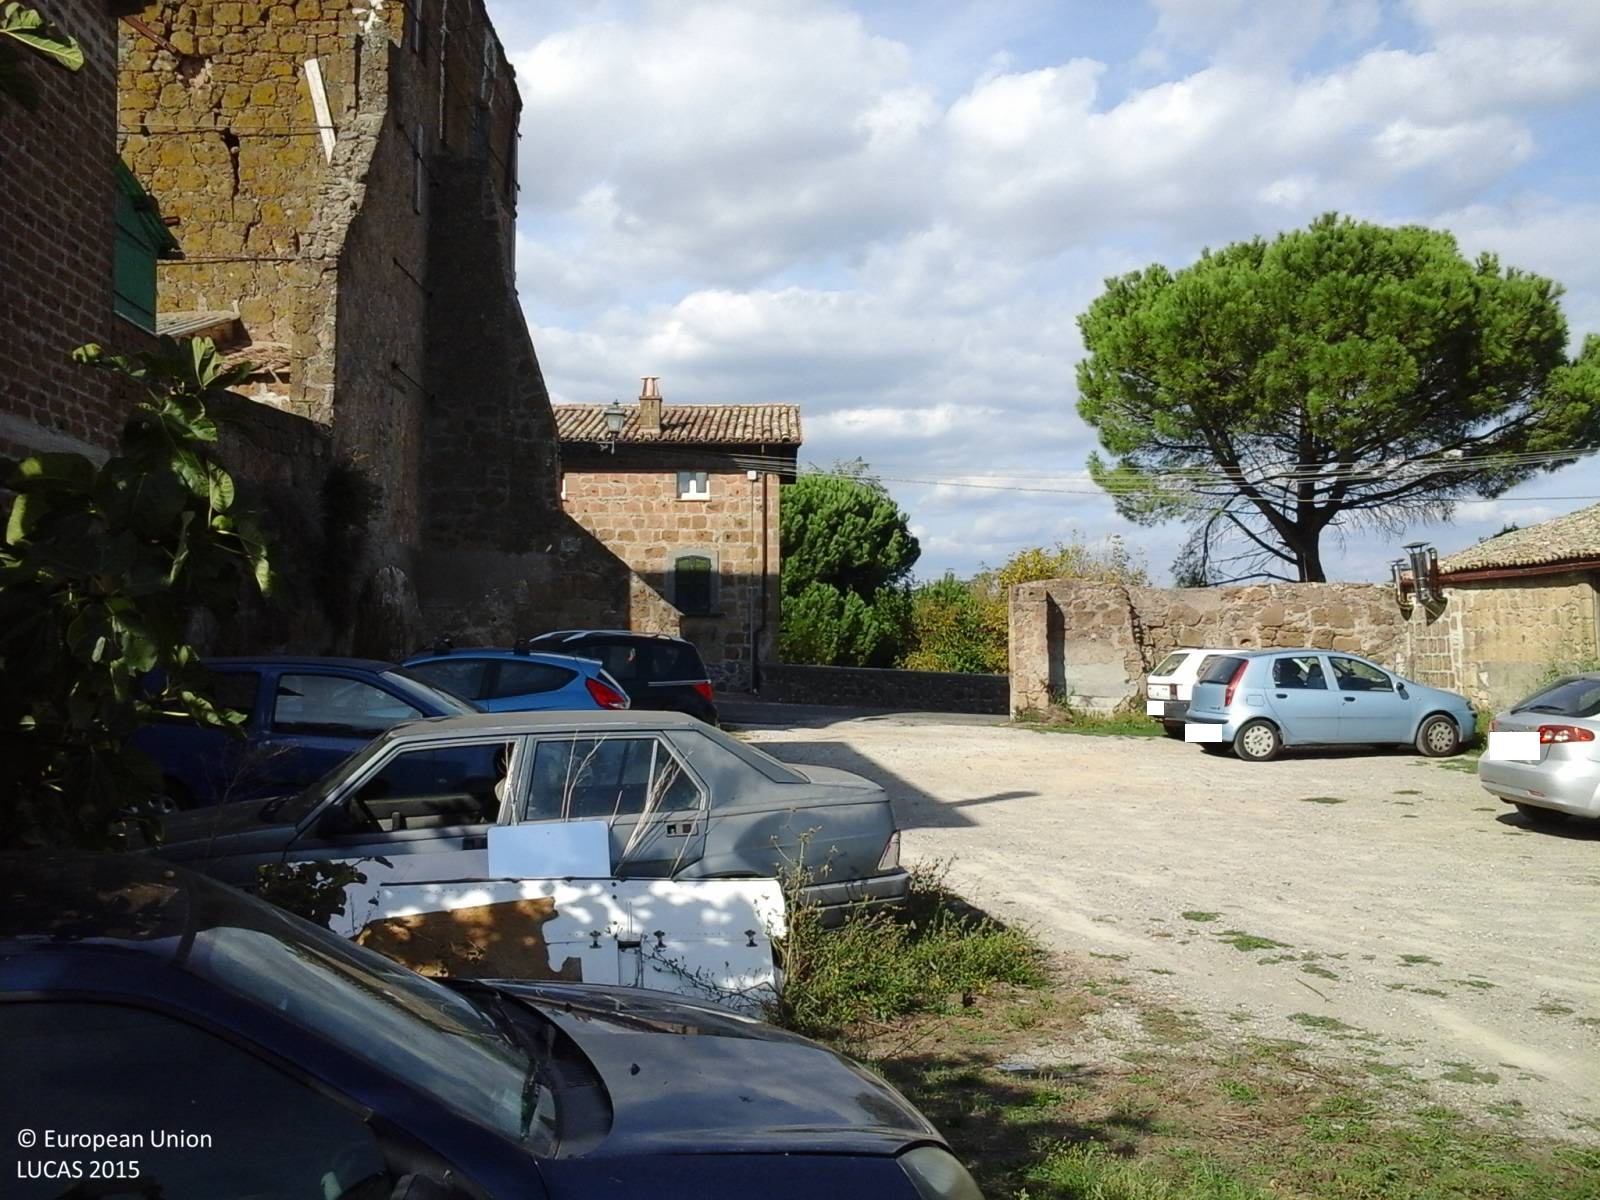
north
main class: Cropland
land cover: Vineyards
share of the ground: 50 - 75 %
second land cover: Grassland without tree/shrub cover
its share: > 75 %
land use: Agriculture (excluding fallow land and kitchen gardens)
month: September
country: IT
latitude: 42.6864
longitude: 12.1046
